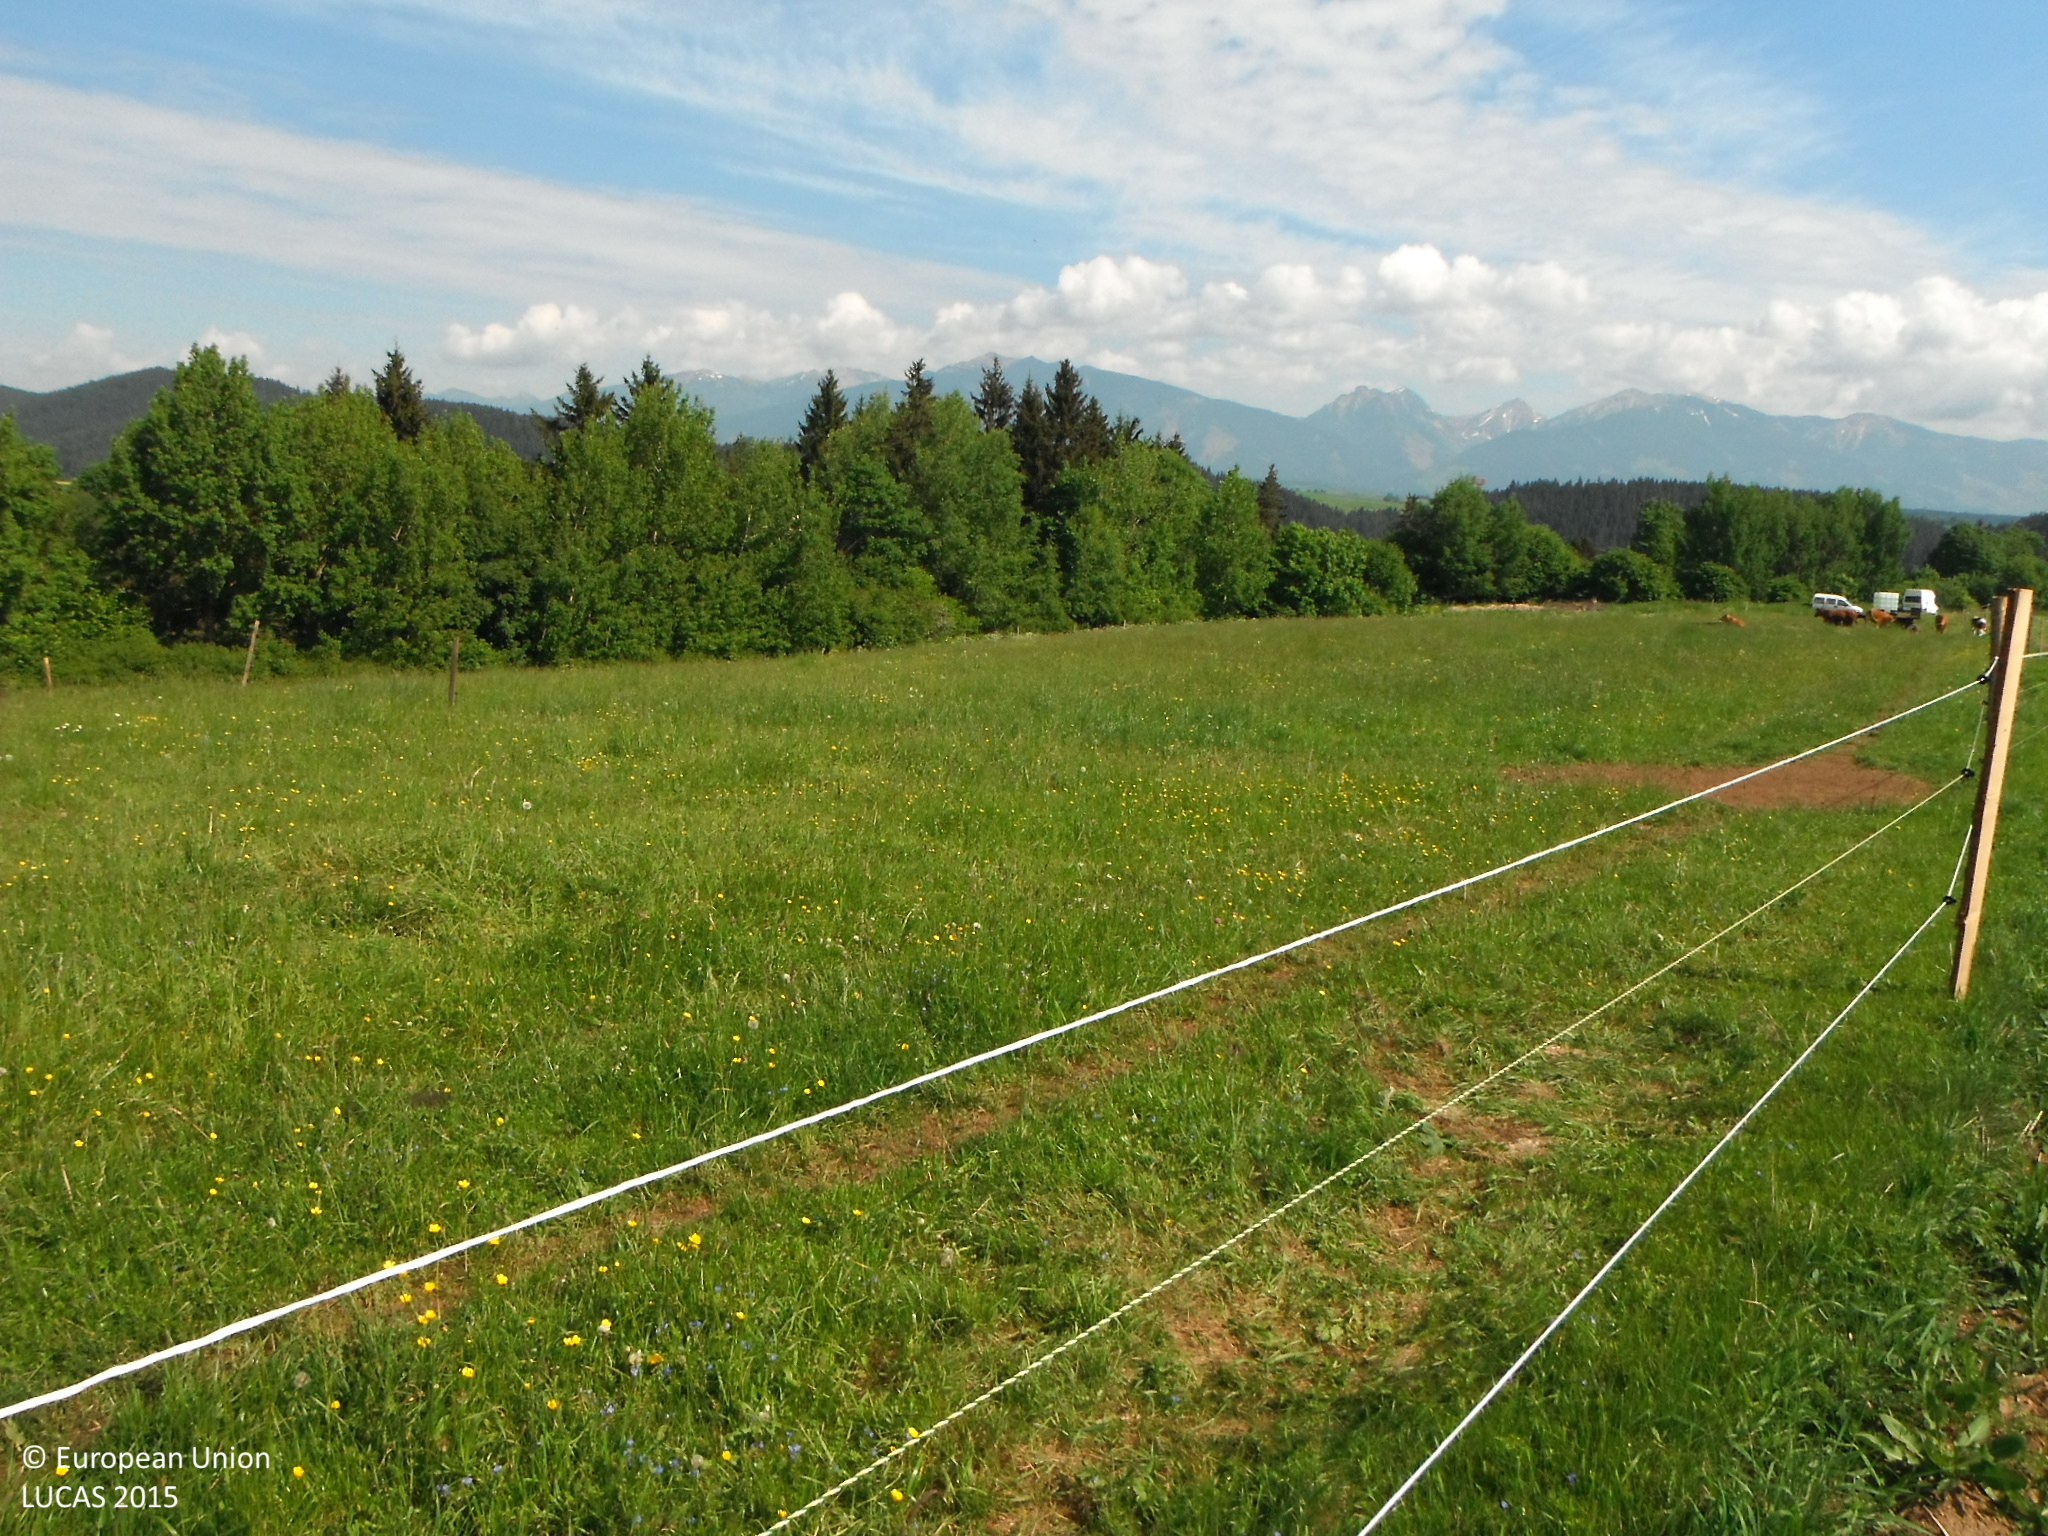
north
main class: Grassland
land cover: Grassland without tree/shrub cover
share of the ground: > 75 %
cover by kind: herbaceous plants 100 %
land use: Agriculture (excluding fallow land and kitchen gardens)
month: June
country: SK
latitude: 49.0201
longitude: 19.7784
